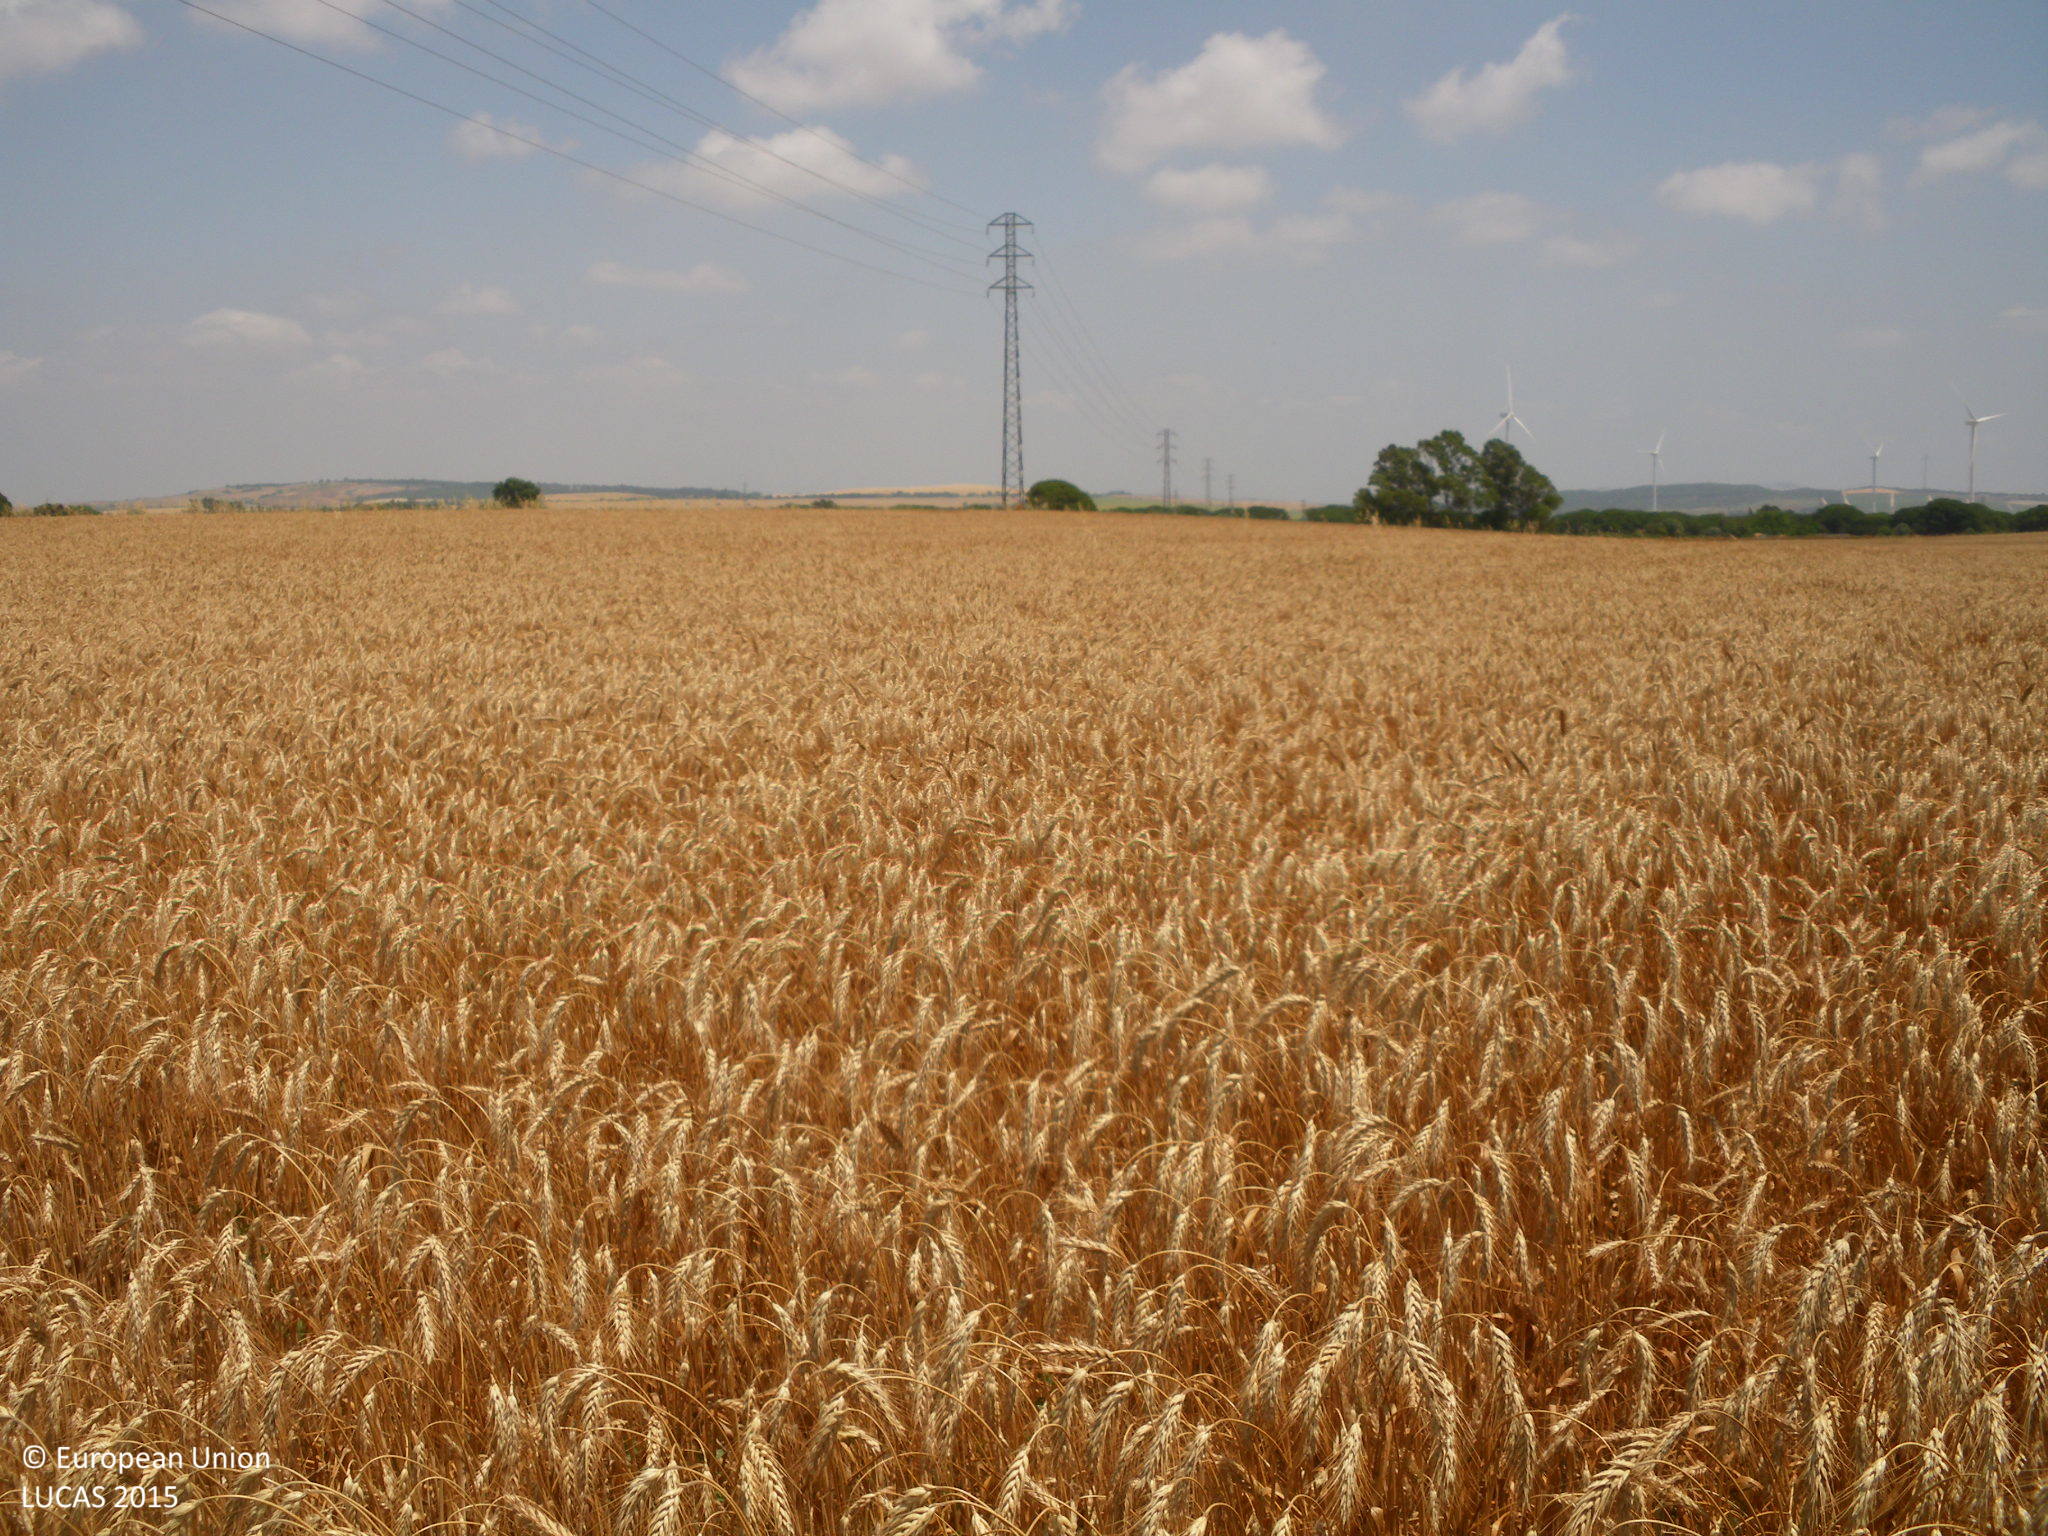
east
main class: Cropland
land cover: Common wheat
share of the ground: > 75 %
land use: Agriculture (excluding fallow land and kitchen gardens)
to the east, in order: Common wheat; Electric lines; Common wheat
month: May
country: ES
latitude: 36.5137
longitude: -6.0988
